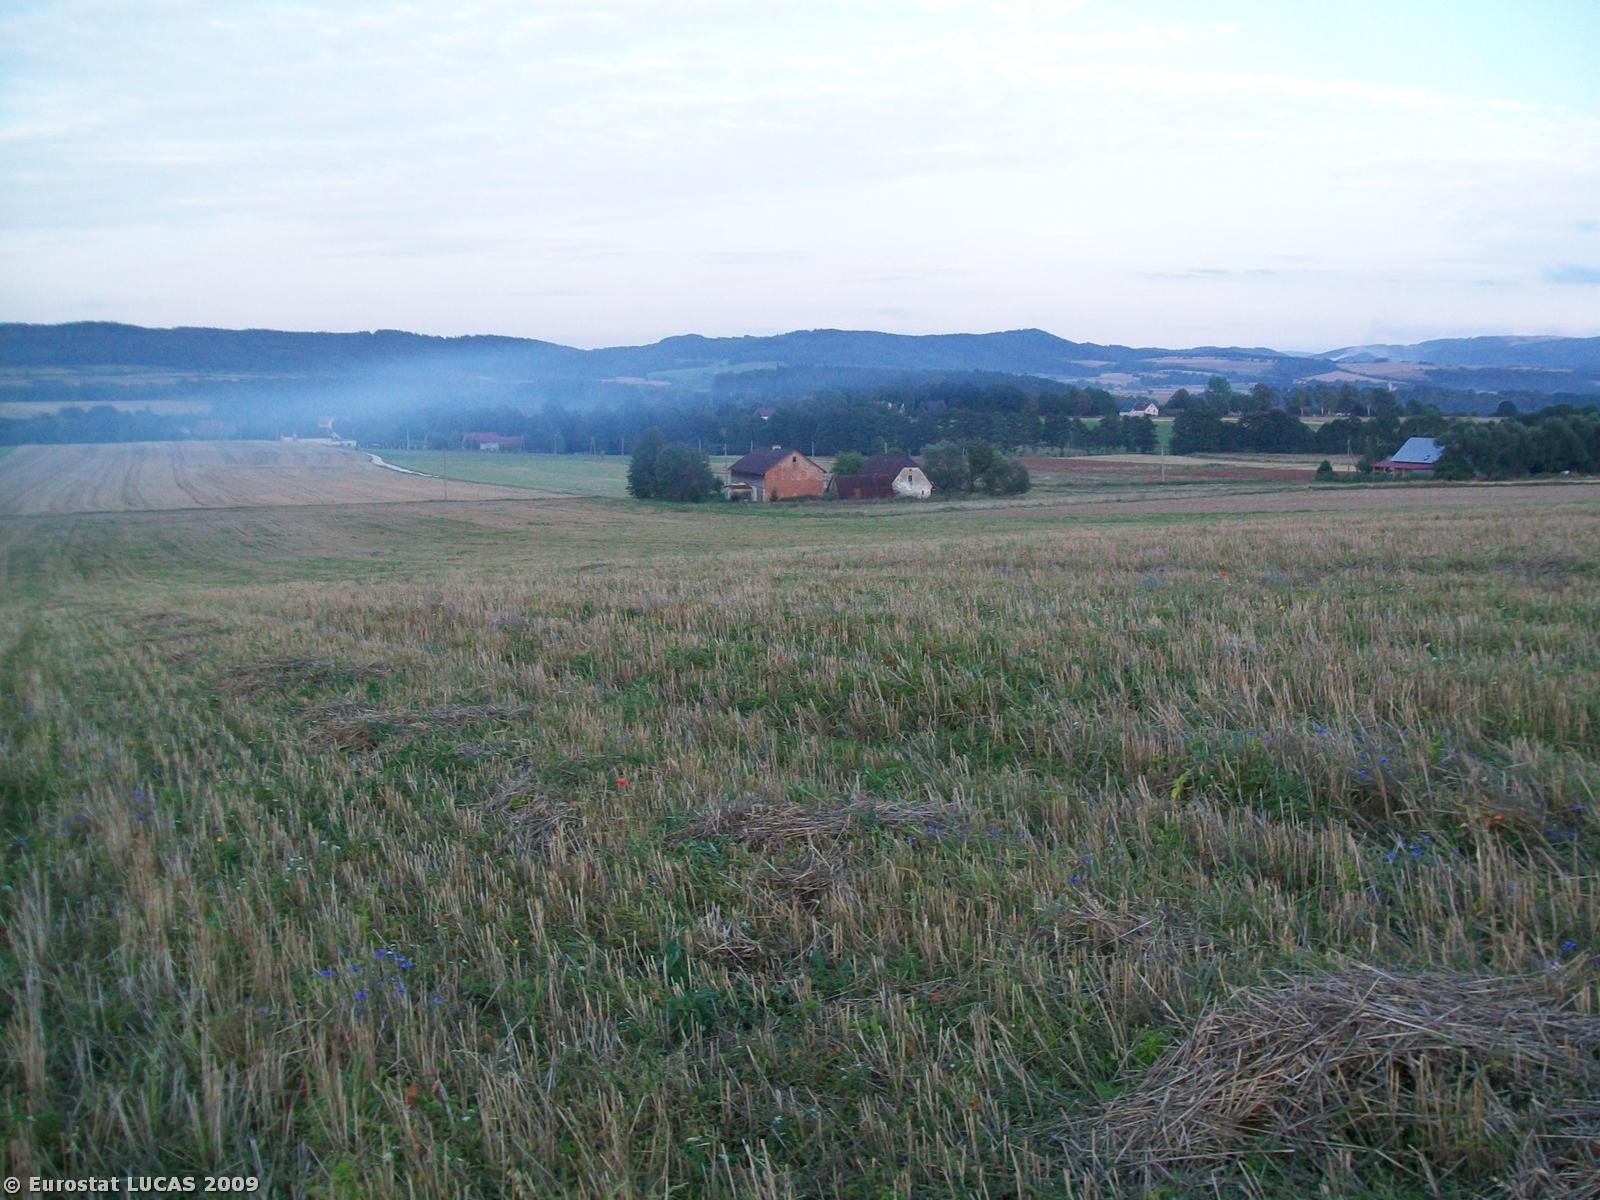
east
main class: Cropland
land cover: Common wheat
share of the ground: < 10 %
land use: Agriculture (excluding fallow land and kitchen gardens)
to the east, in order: Common wheat; Tracks; Grassland without tree/shrub cover; Artificial constructions in urban areas; Spontaneously vegetated surfaces
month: July
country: PL
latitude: 50.3343
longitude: 16.6253
